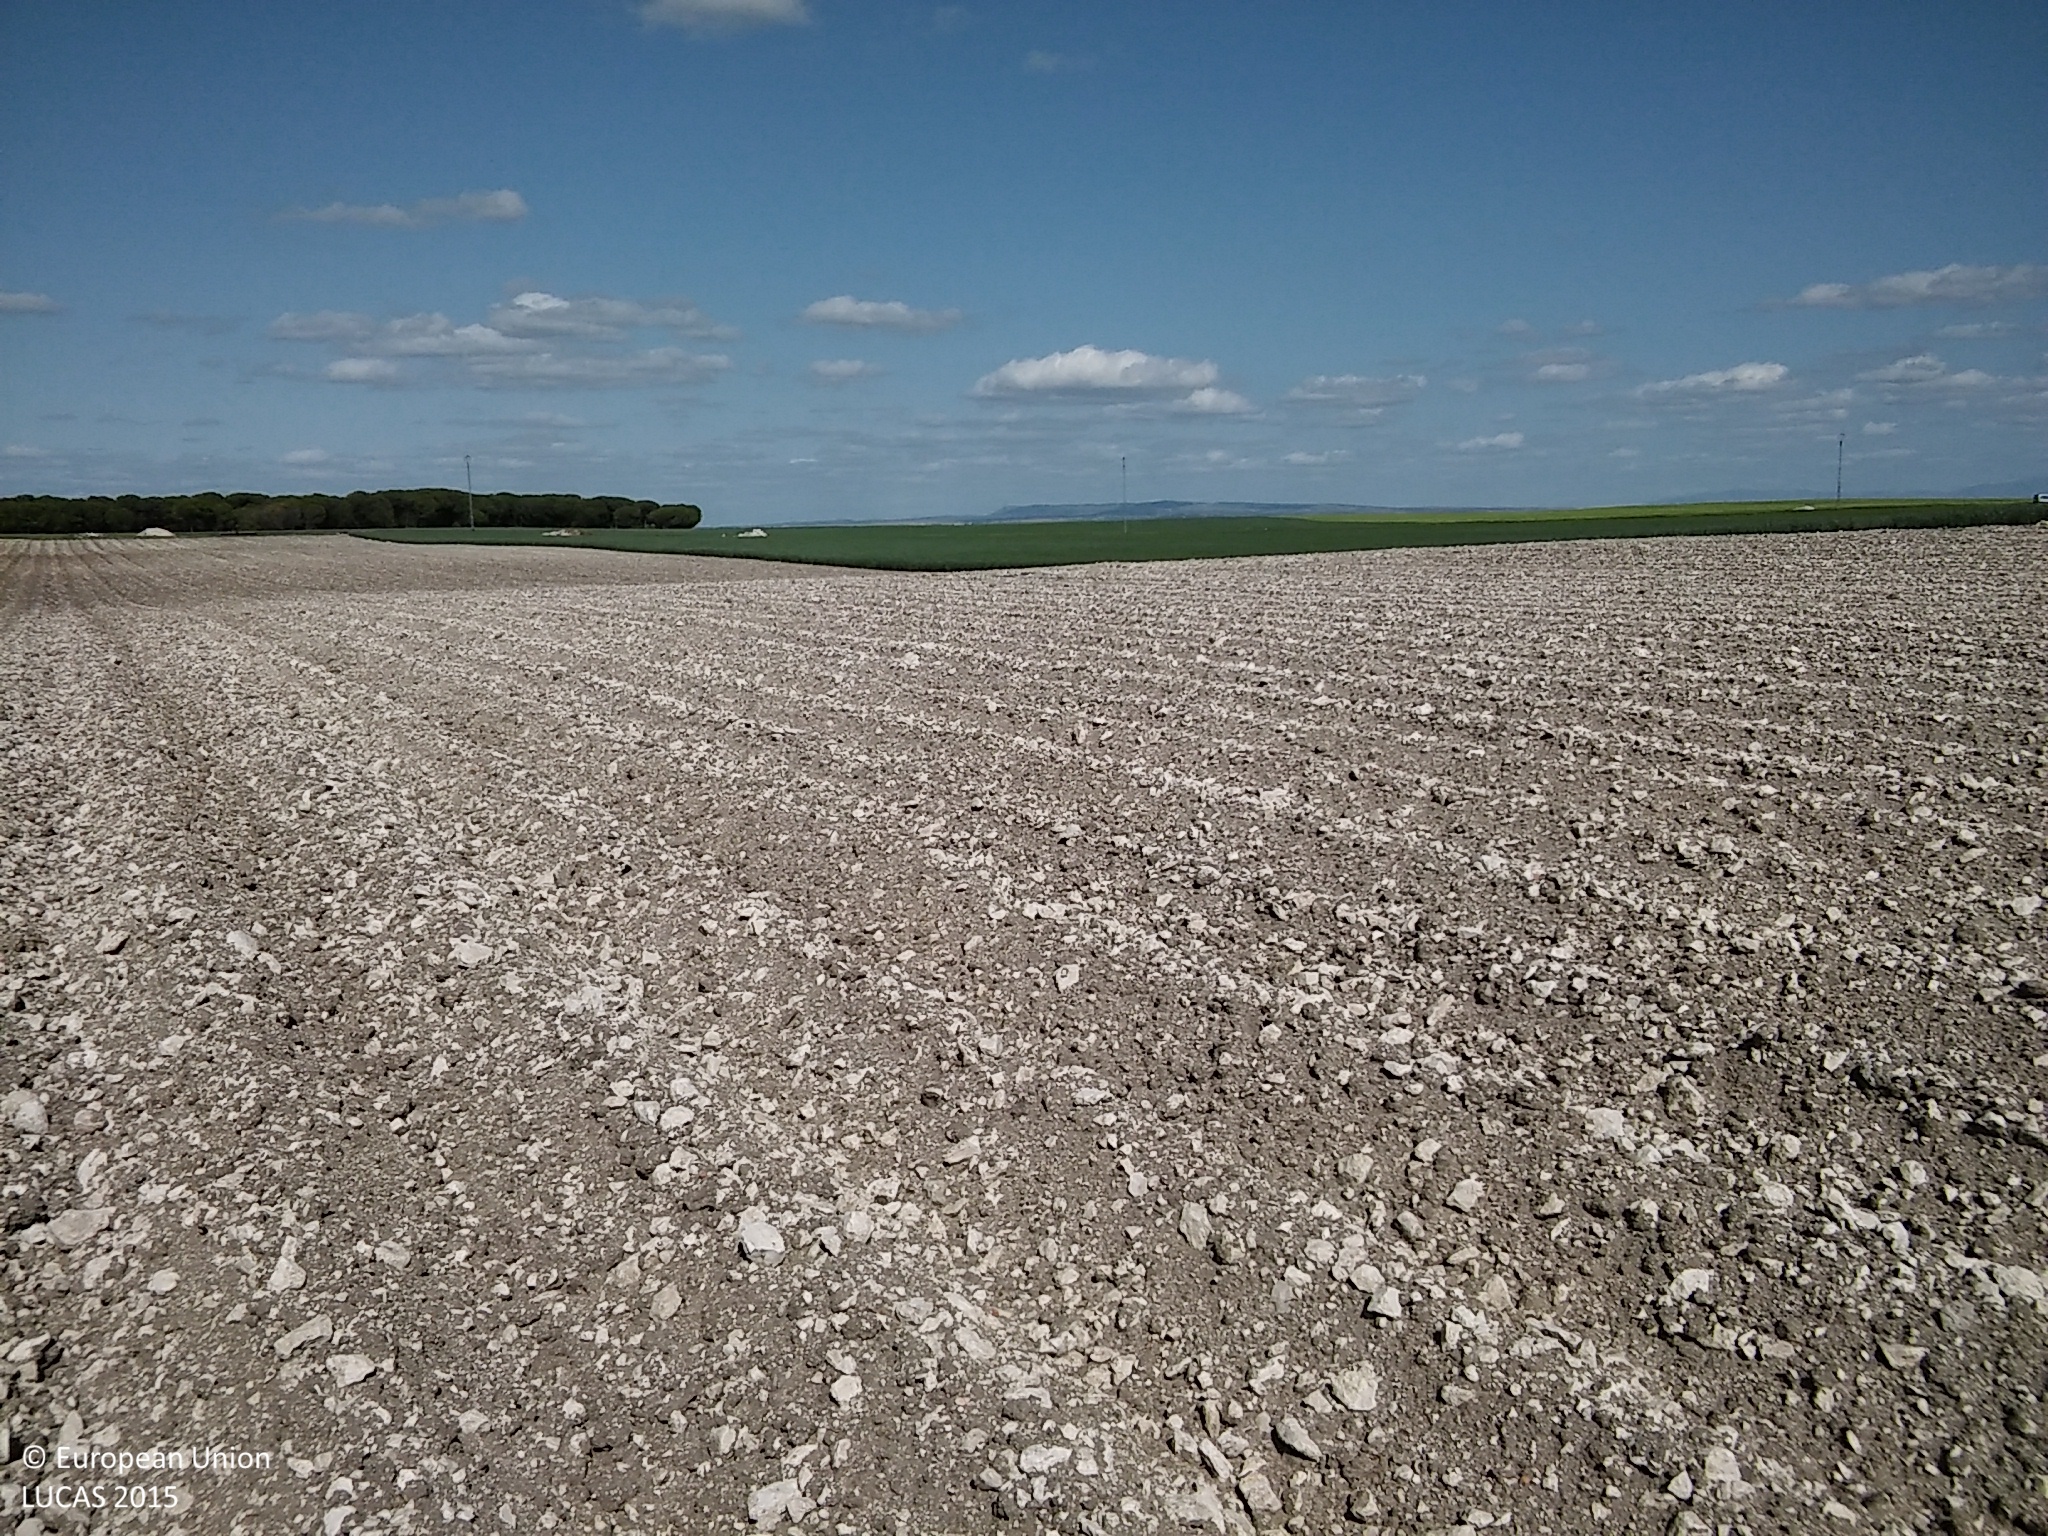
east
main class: Cropland
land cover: Potatoes
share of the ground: < 10 %
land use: Agriculture (excluding fallow land and kitchen gardens)
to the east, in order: Potatoes; Common wheat; Grassland without tree/shrub cover; Electric lines; Grassland without tree/shrub cover; Tracks; Grassland without tree/shrub cover; Common wheat
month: May
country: ES
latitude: 41.4362
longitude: -4.1428
